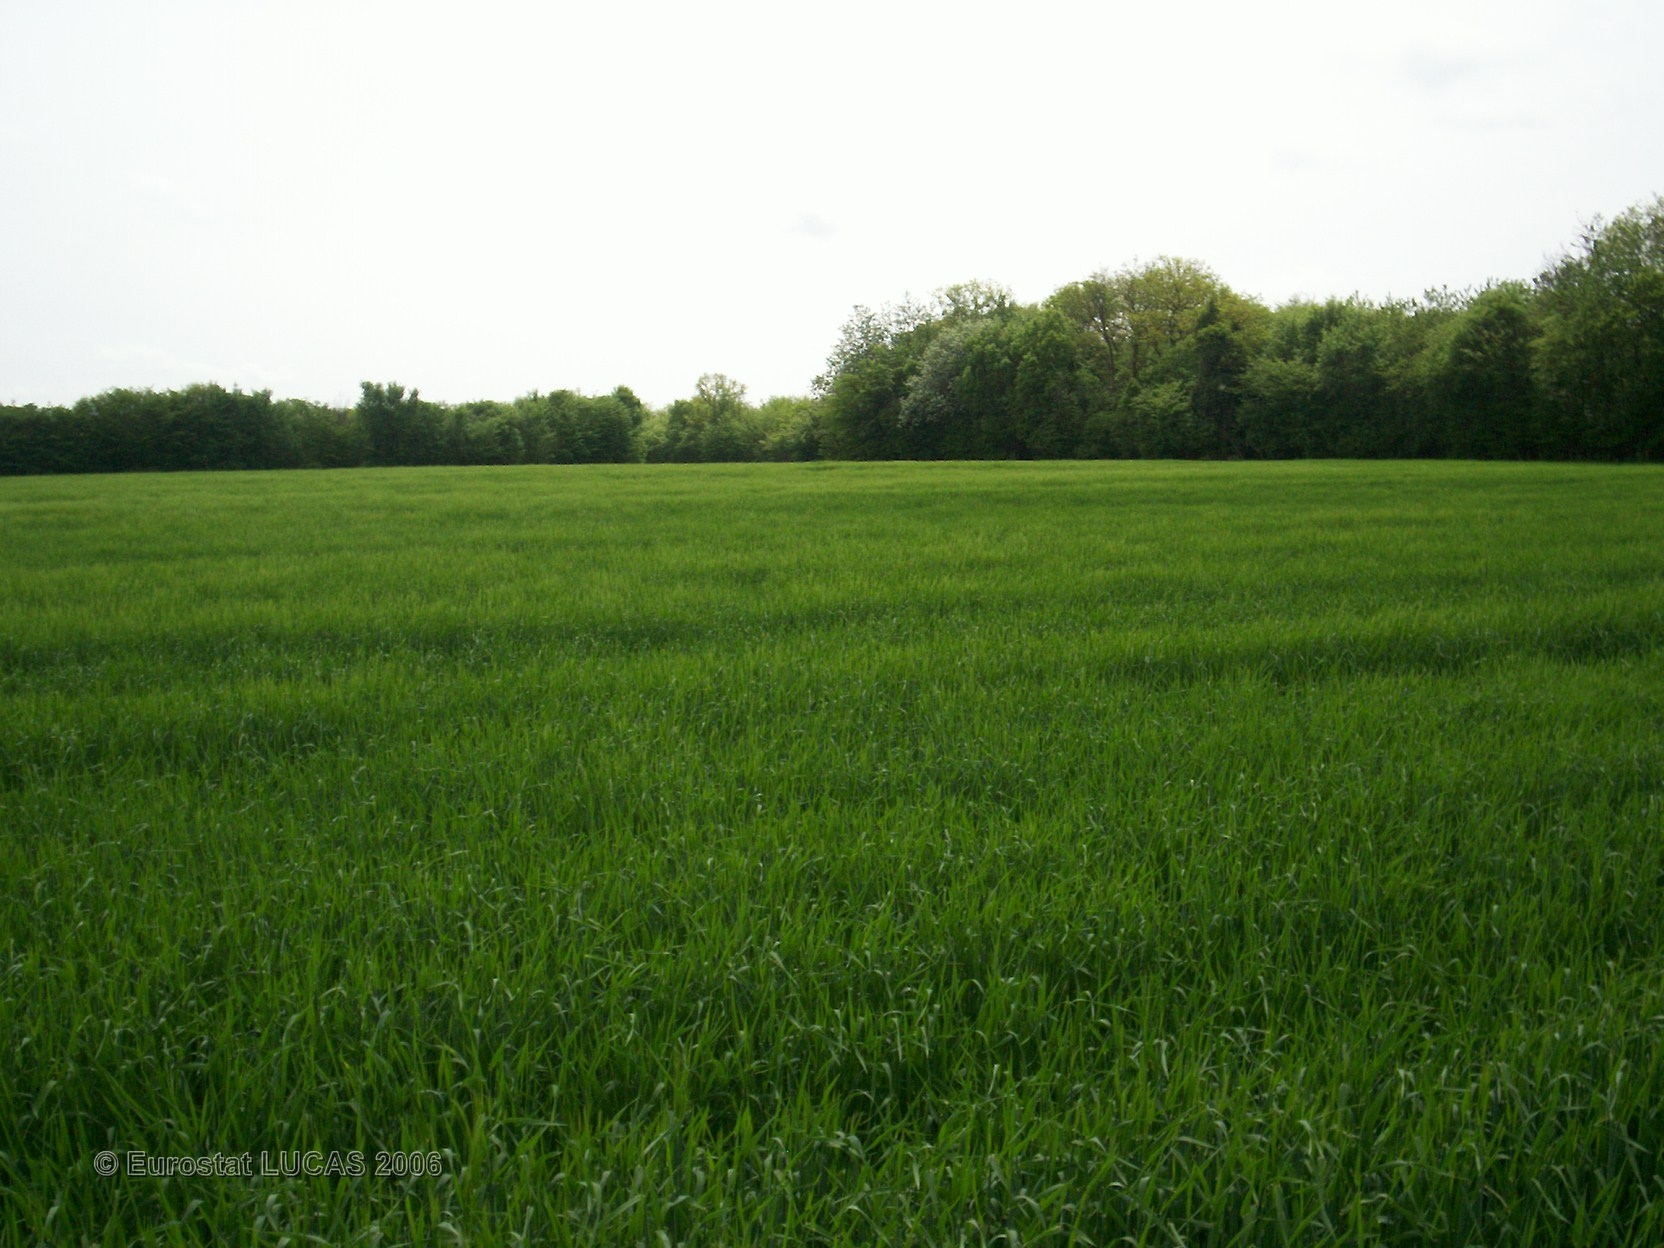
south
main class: Cropland
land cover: Barley
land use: Agriculture (excluding fallow land and kitchen gardens)
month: May
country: FR
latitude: 47.3317
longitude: 4.5608
